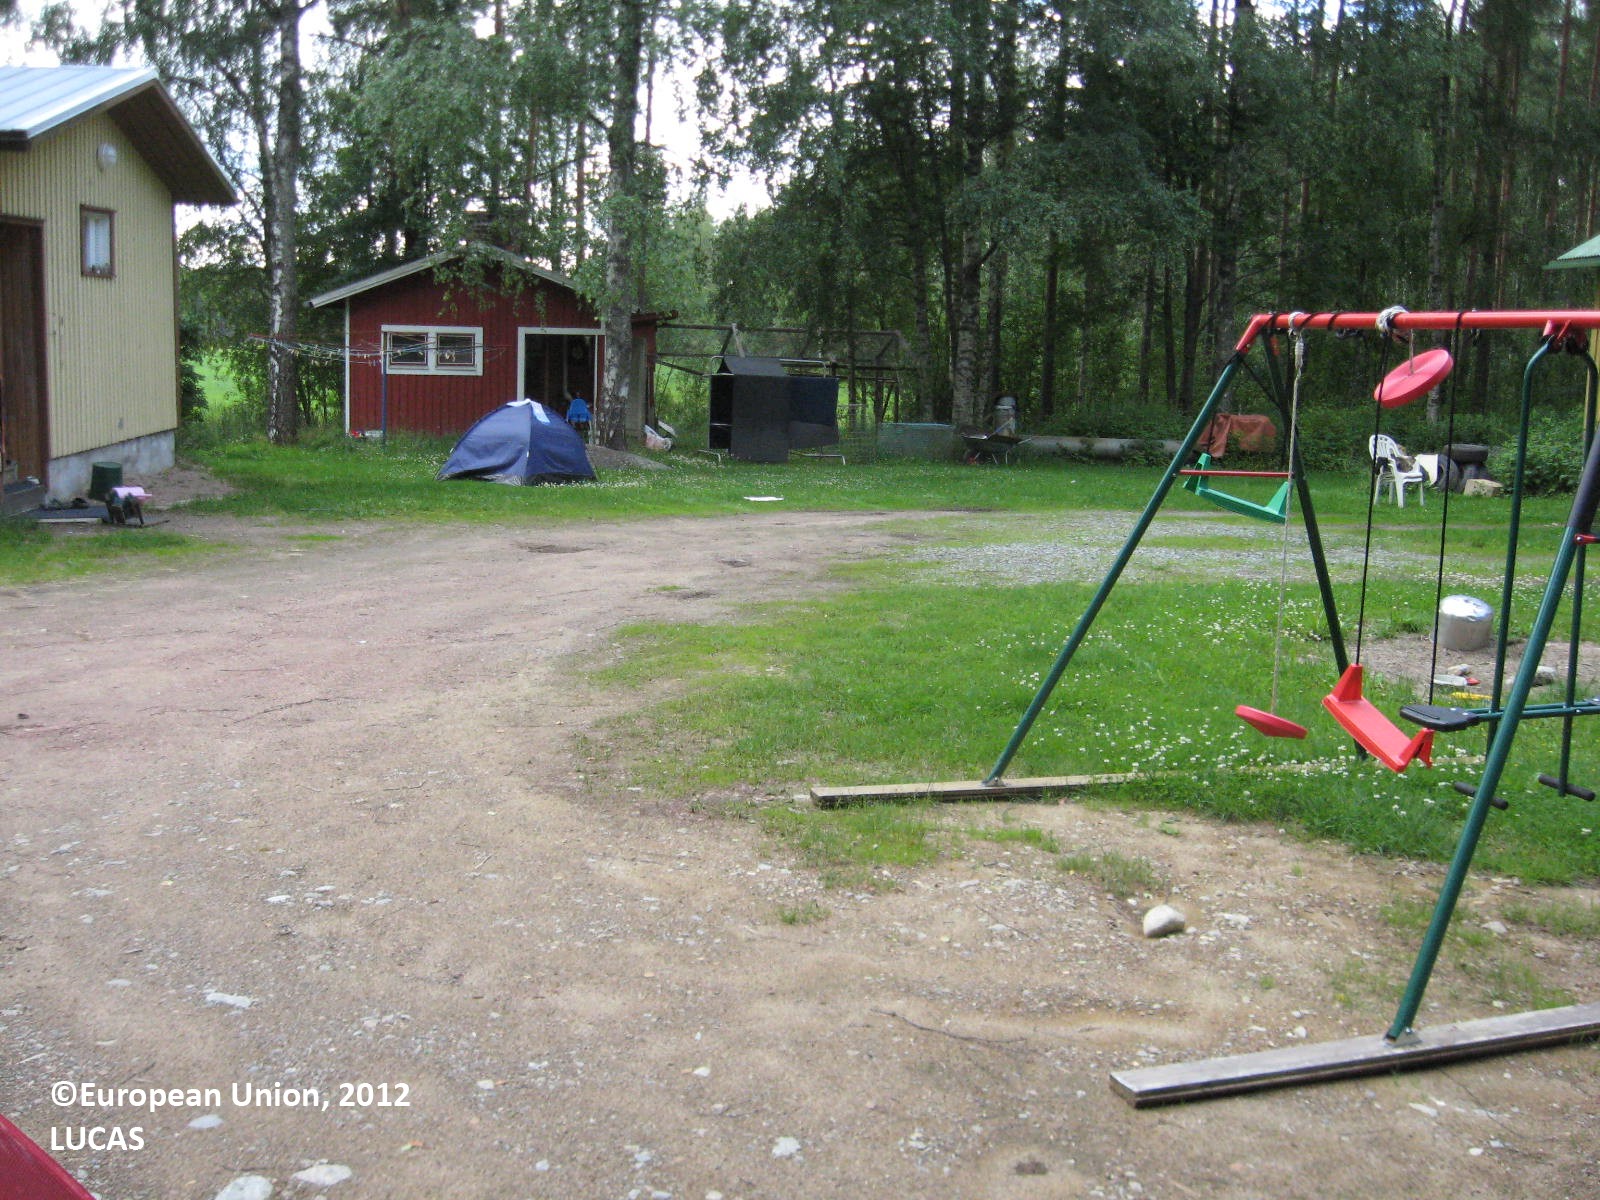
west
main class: Woodland
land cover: Pine dominated coniferous woodland
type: boreal forest
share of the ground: > 75 %
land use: Forestry
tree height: > 5 m
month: July
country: FI
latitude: 62.3104
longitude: 22.6951
